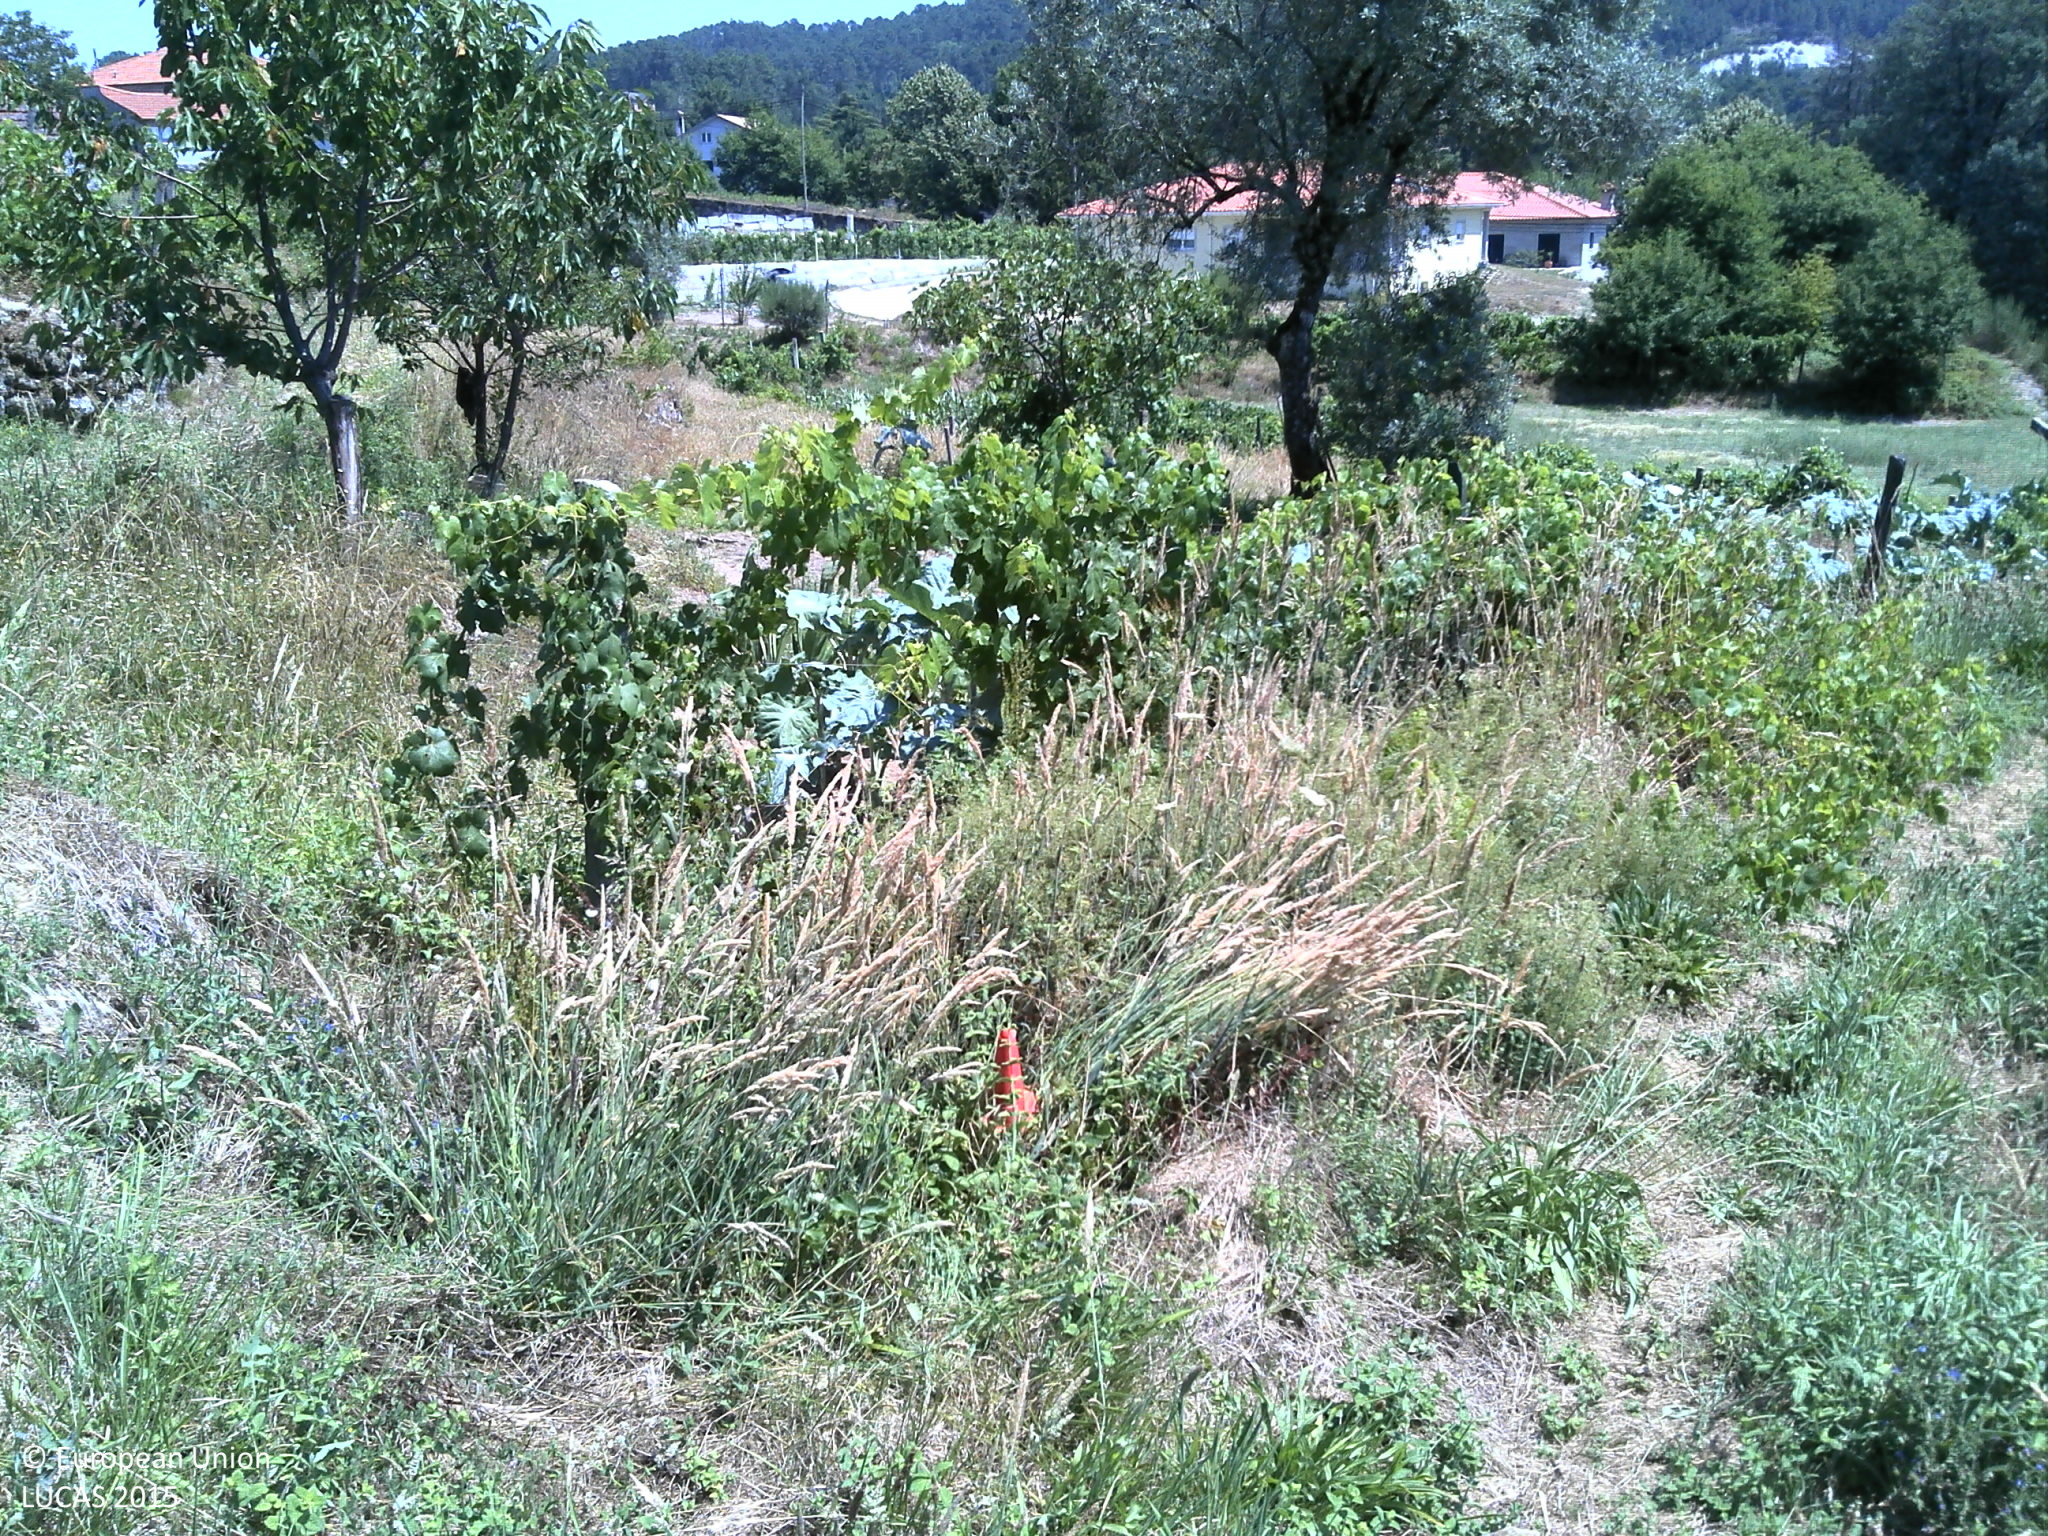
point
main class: Grassland
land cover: Grassland without tree/shrub cover
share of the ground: > 75 %
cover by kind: herbaceous plants 100 %
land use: Agriculture (excluding fallow land and kitchen gardens)
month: July
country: PT
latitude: 40.8618
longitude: -7.8872
